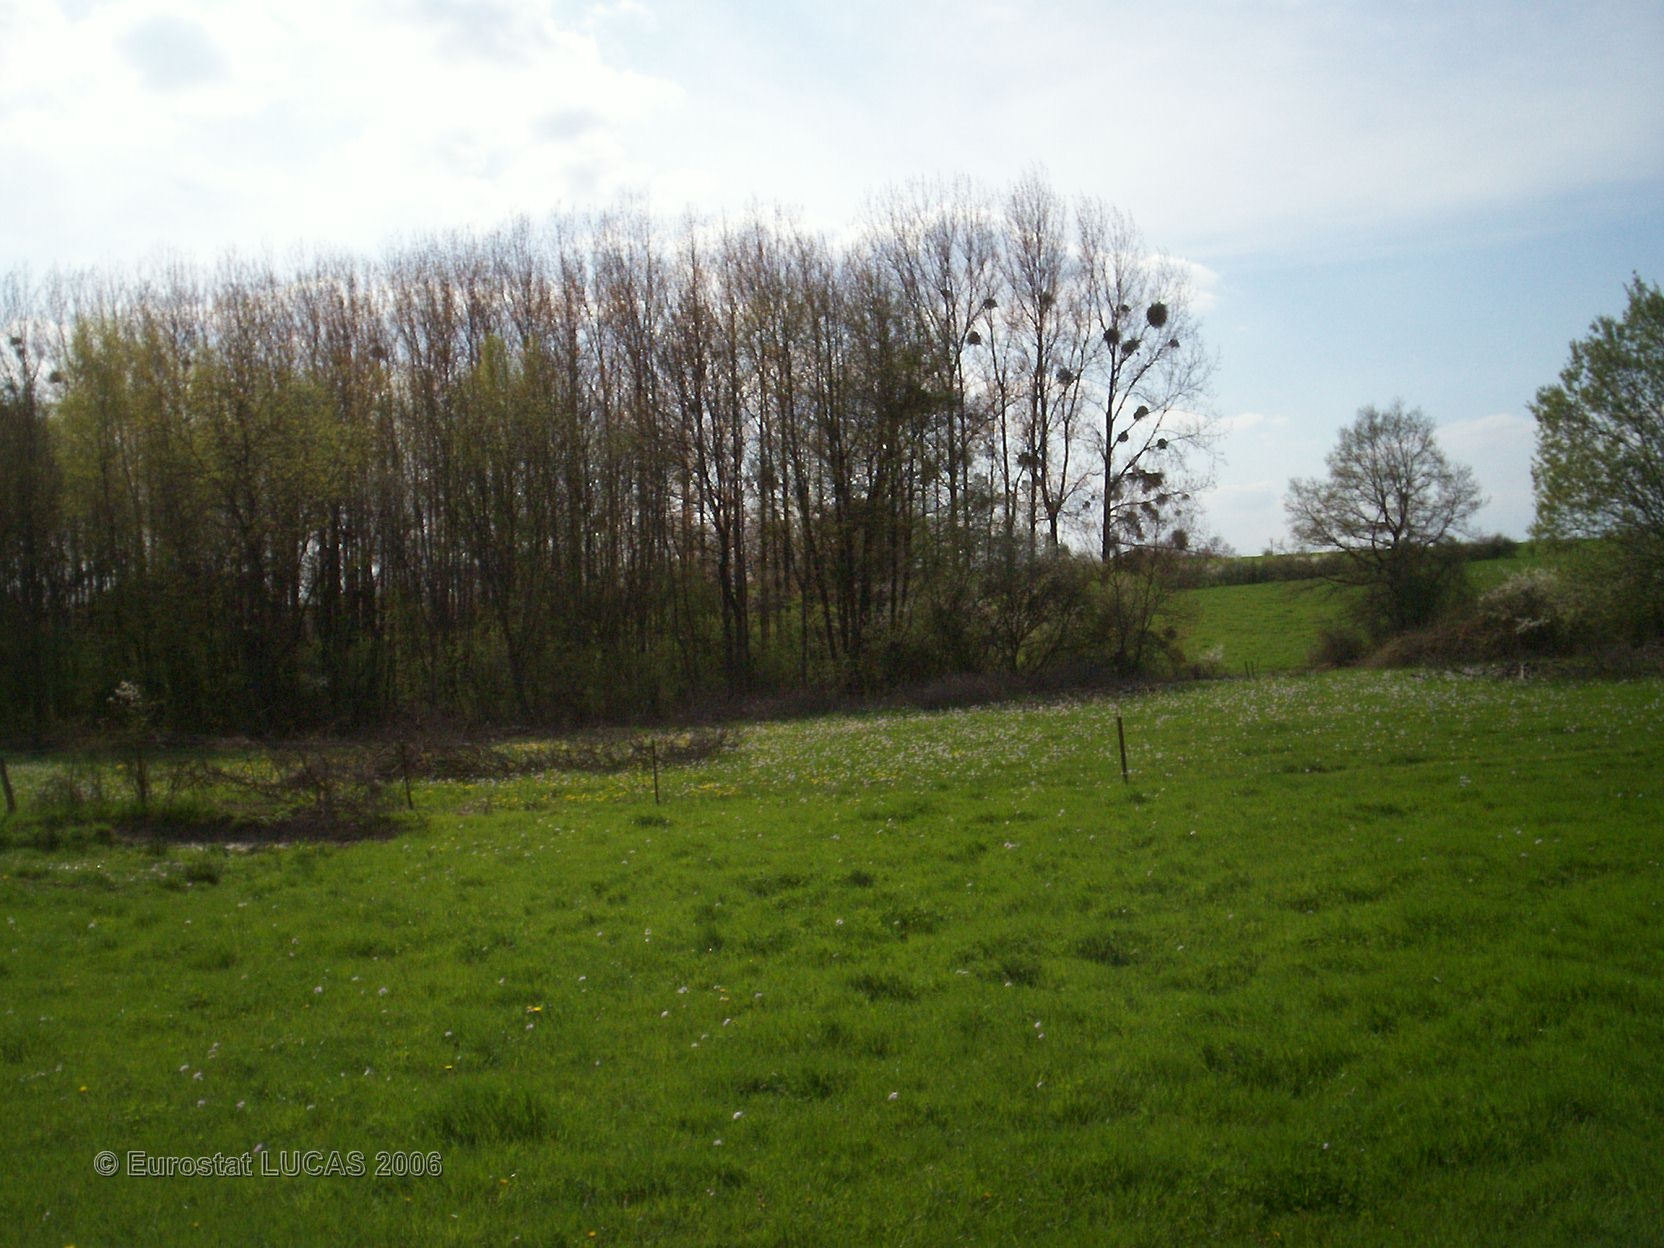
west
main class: Grassland
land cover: Grassland without tree/shrub cover
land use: Agriculture (excluding fallow land and kitchen gardens)
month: April
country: FR
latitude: 49.7349
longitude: 4.2930
